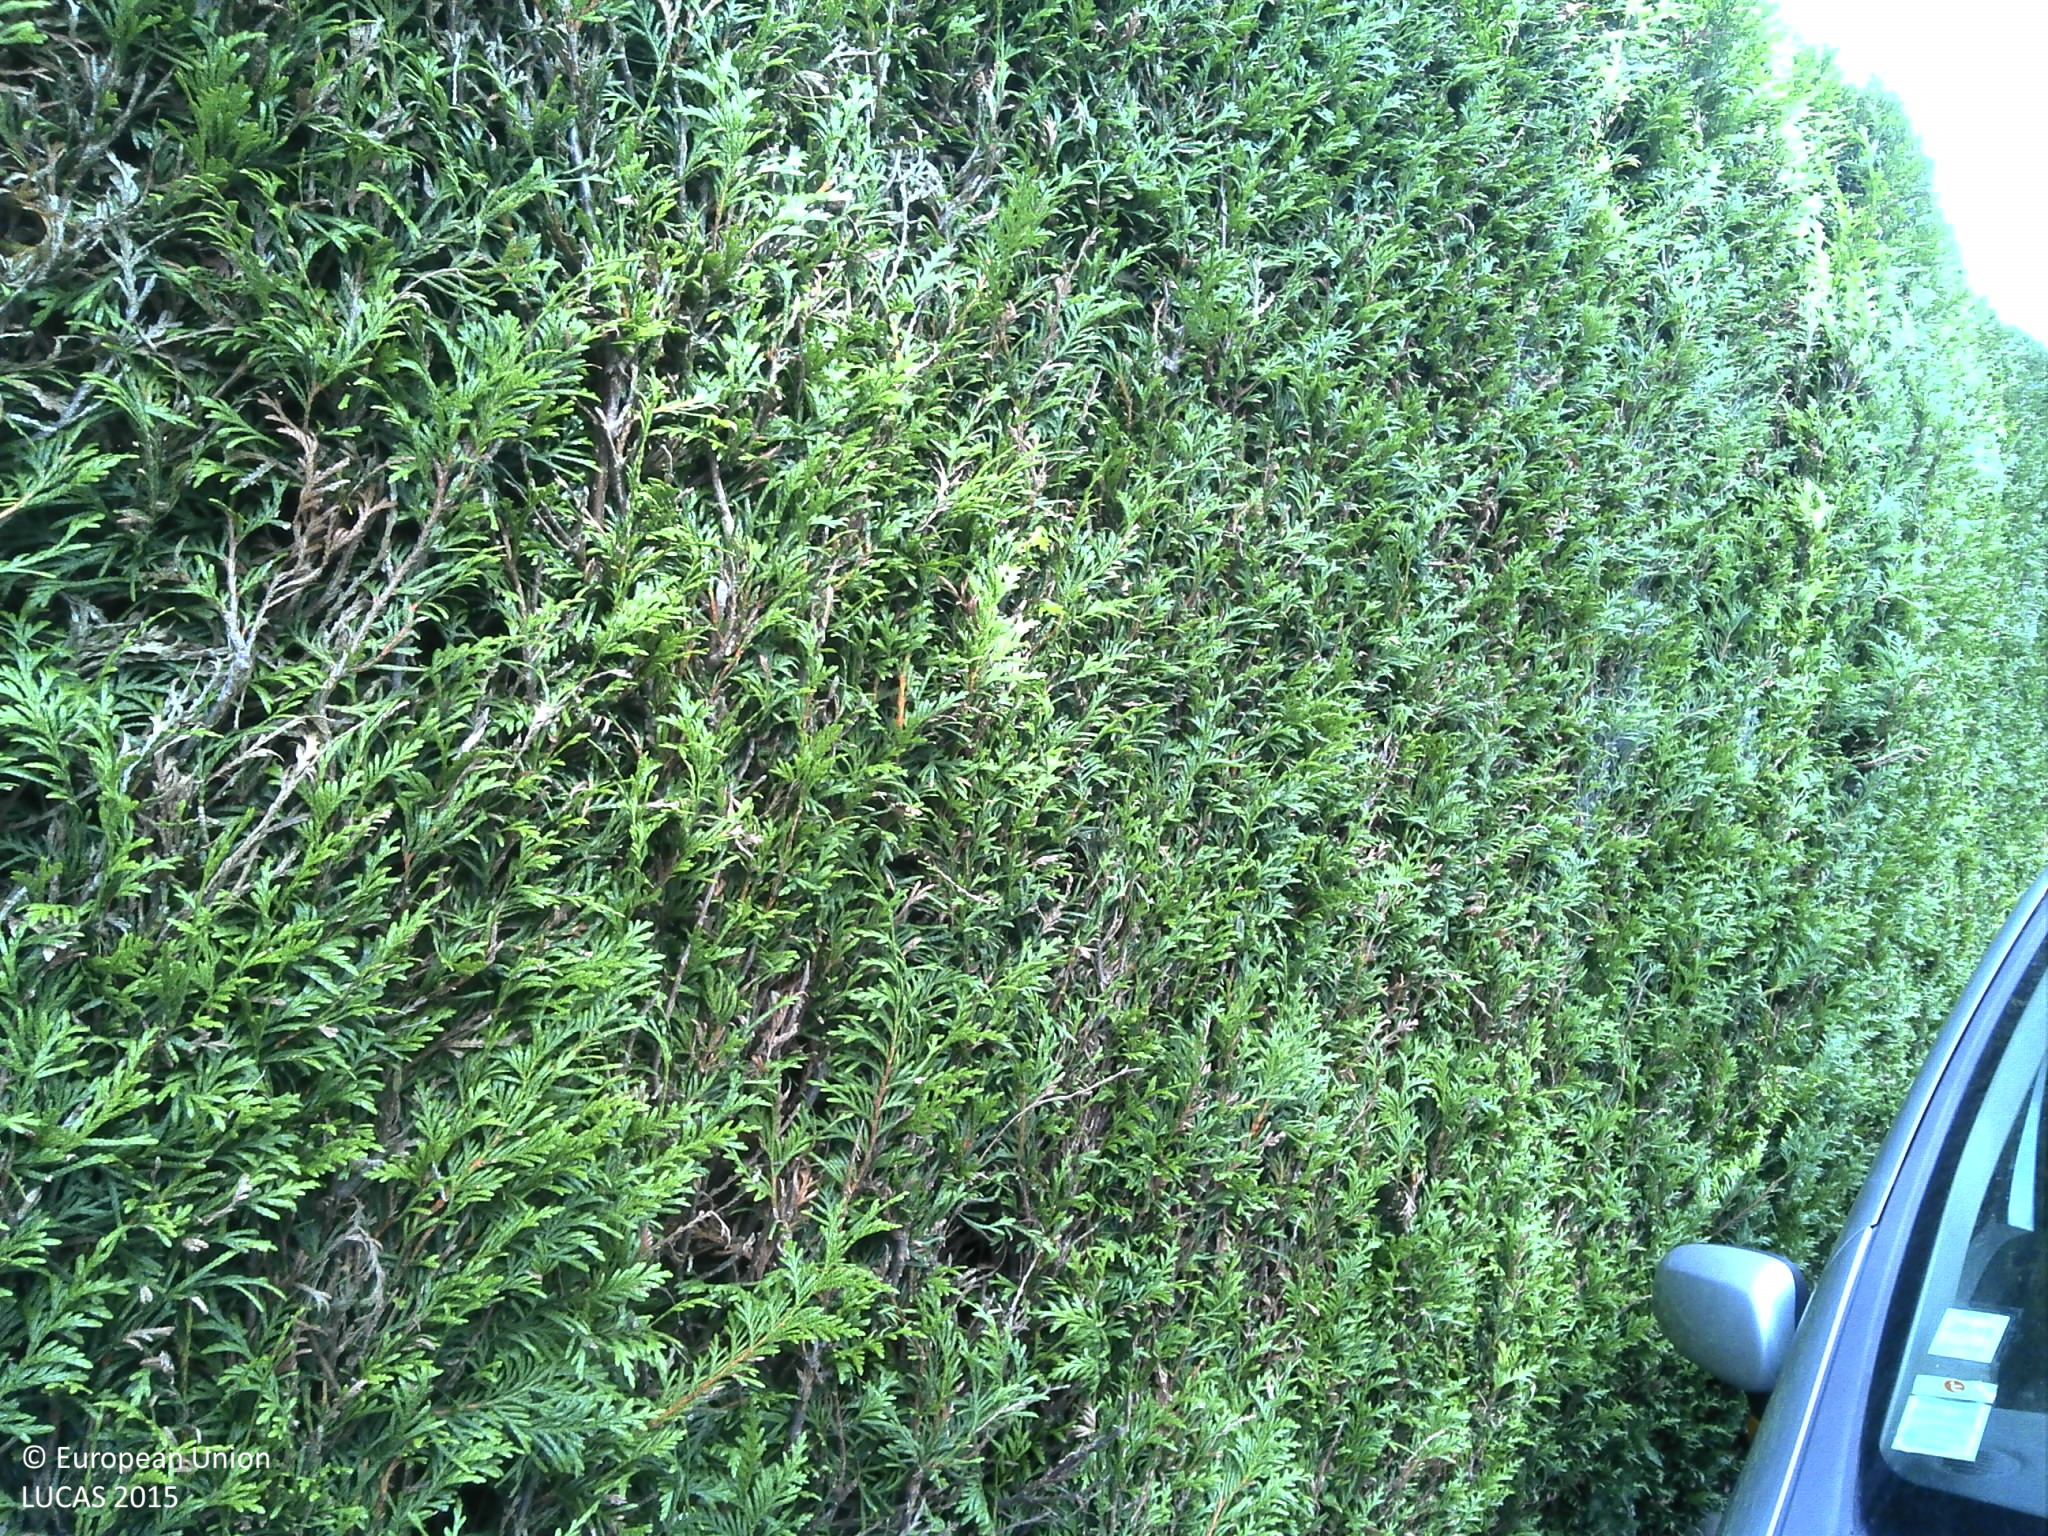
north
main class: Grassland
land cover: Grassland with sparse tree/shrub cover
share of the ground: > 75 %
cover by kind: herbaceous plants 95 %, broadleaved forest trees 5 %
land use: Residential
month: July
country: FR
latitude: 48.5796
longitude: 1.9479
